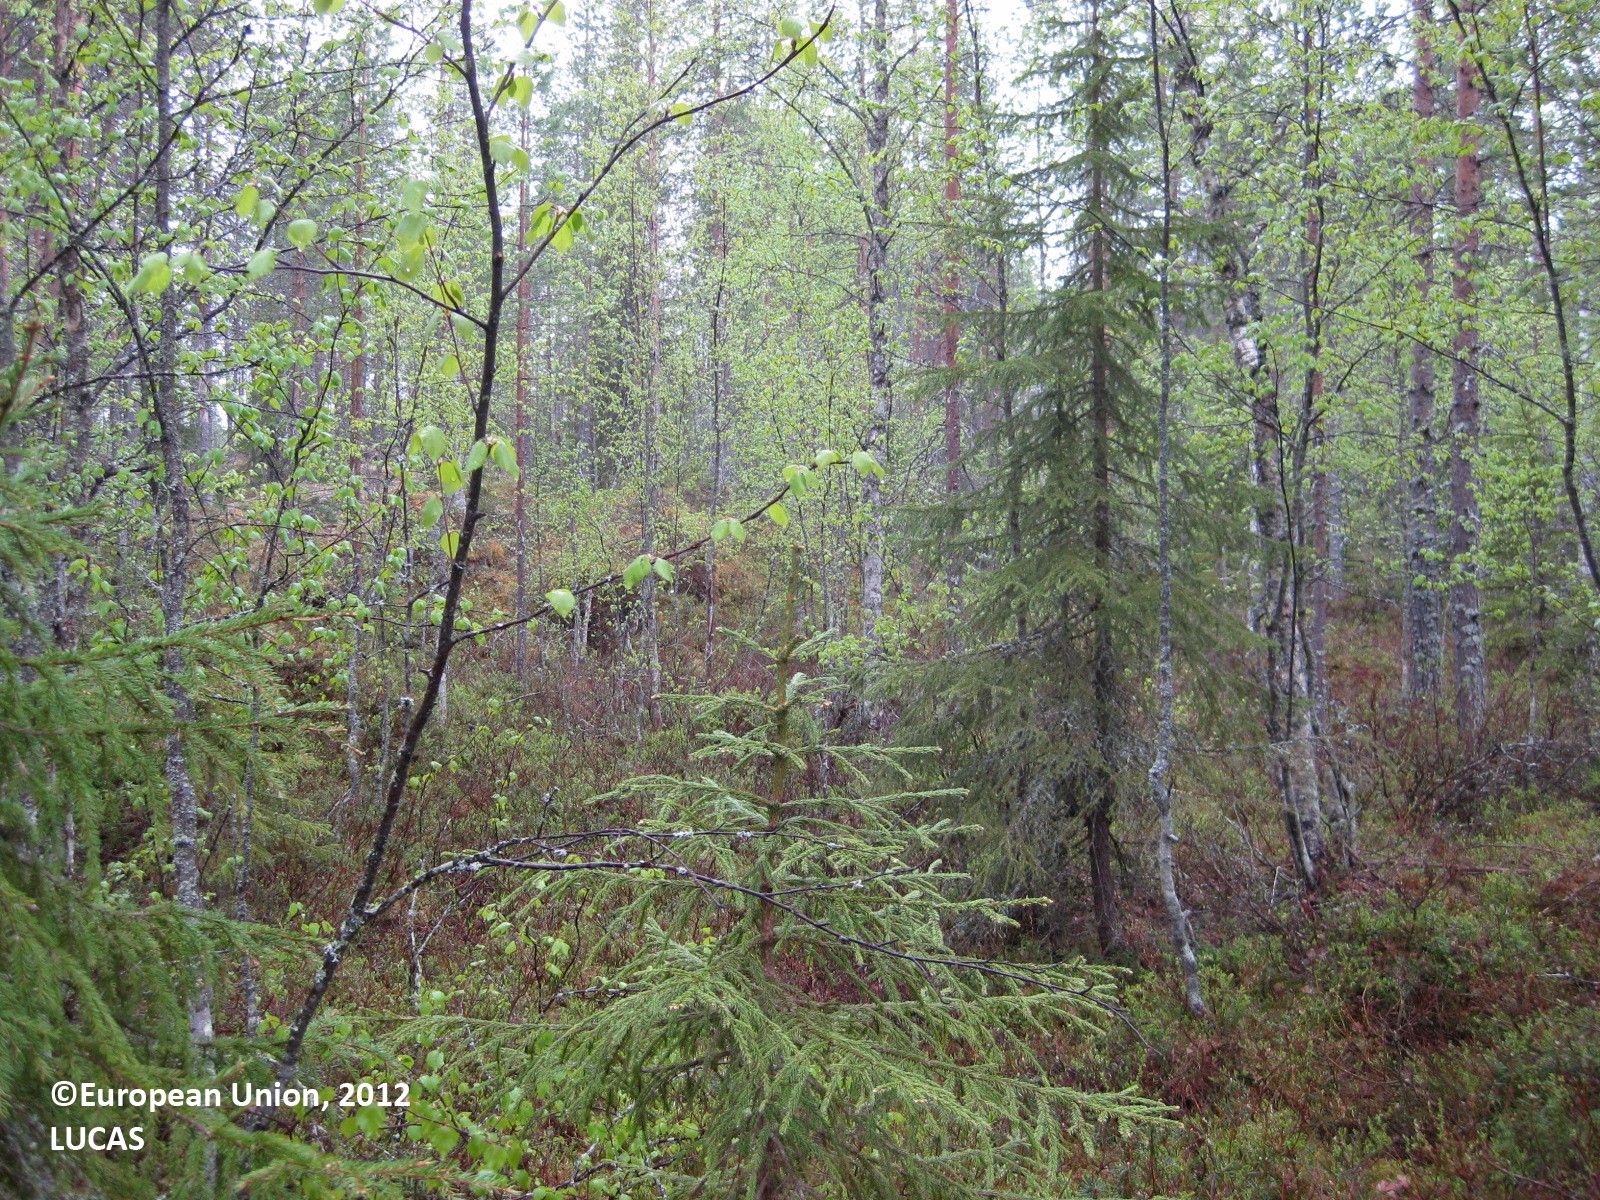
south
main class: Woodland
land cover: Other mixed woodland
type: boreal forest
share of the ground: > 75 %
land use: Forestry
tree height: > 5 m
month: June
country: FI
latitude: 65.2982
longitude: 29.2575
